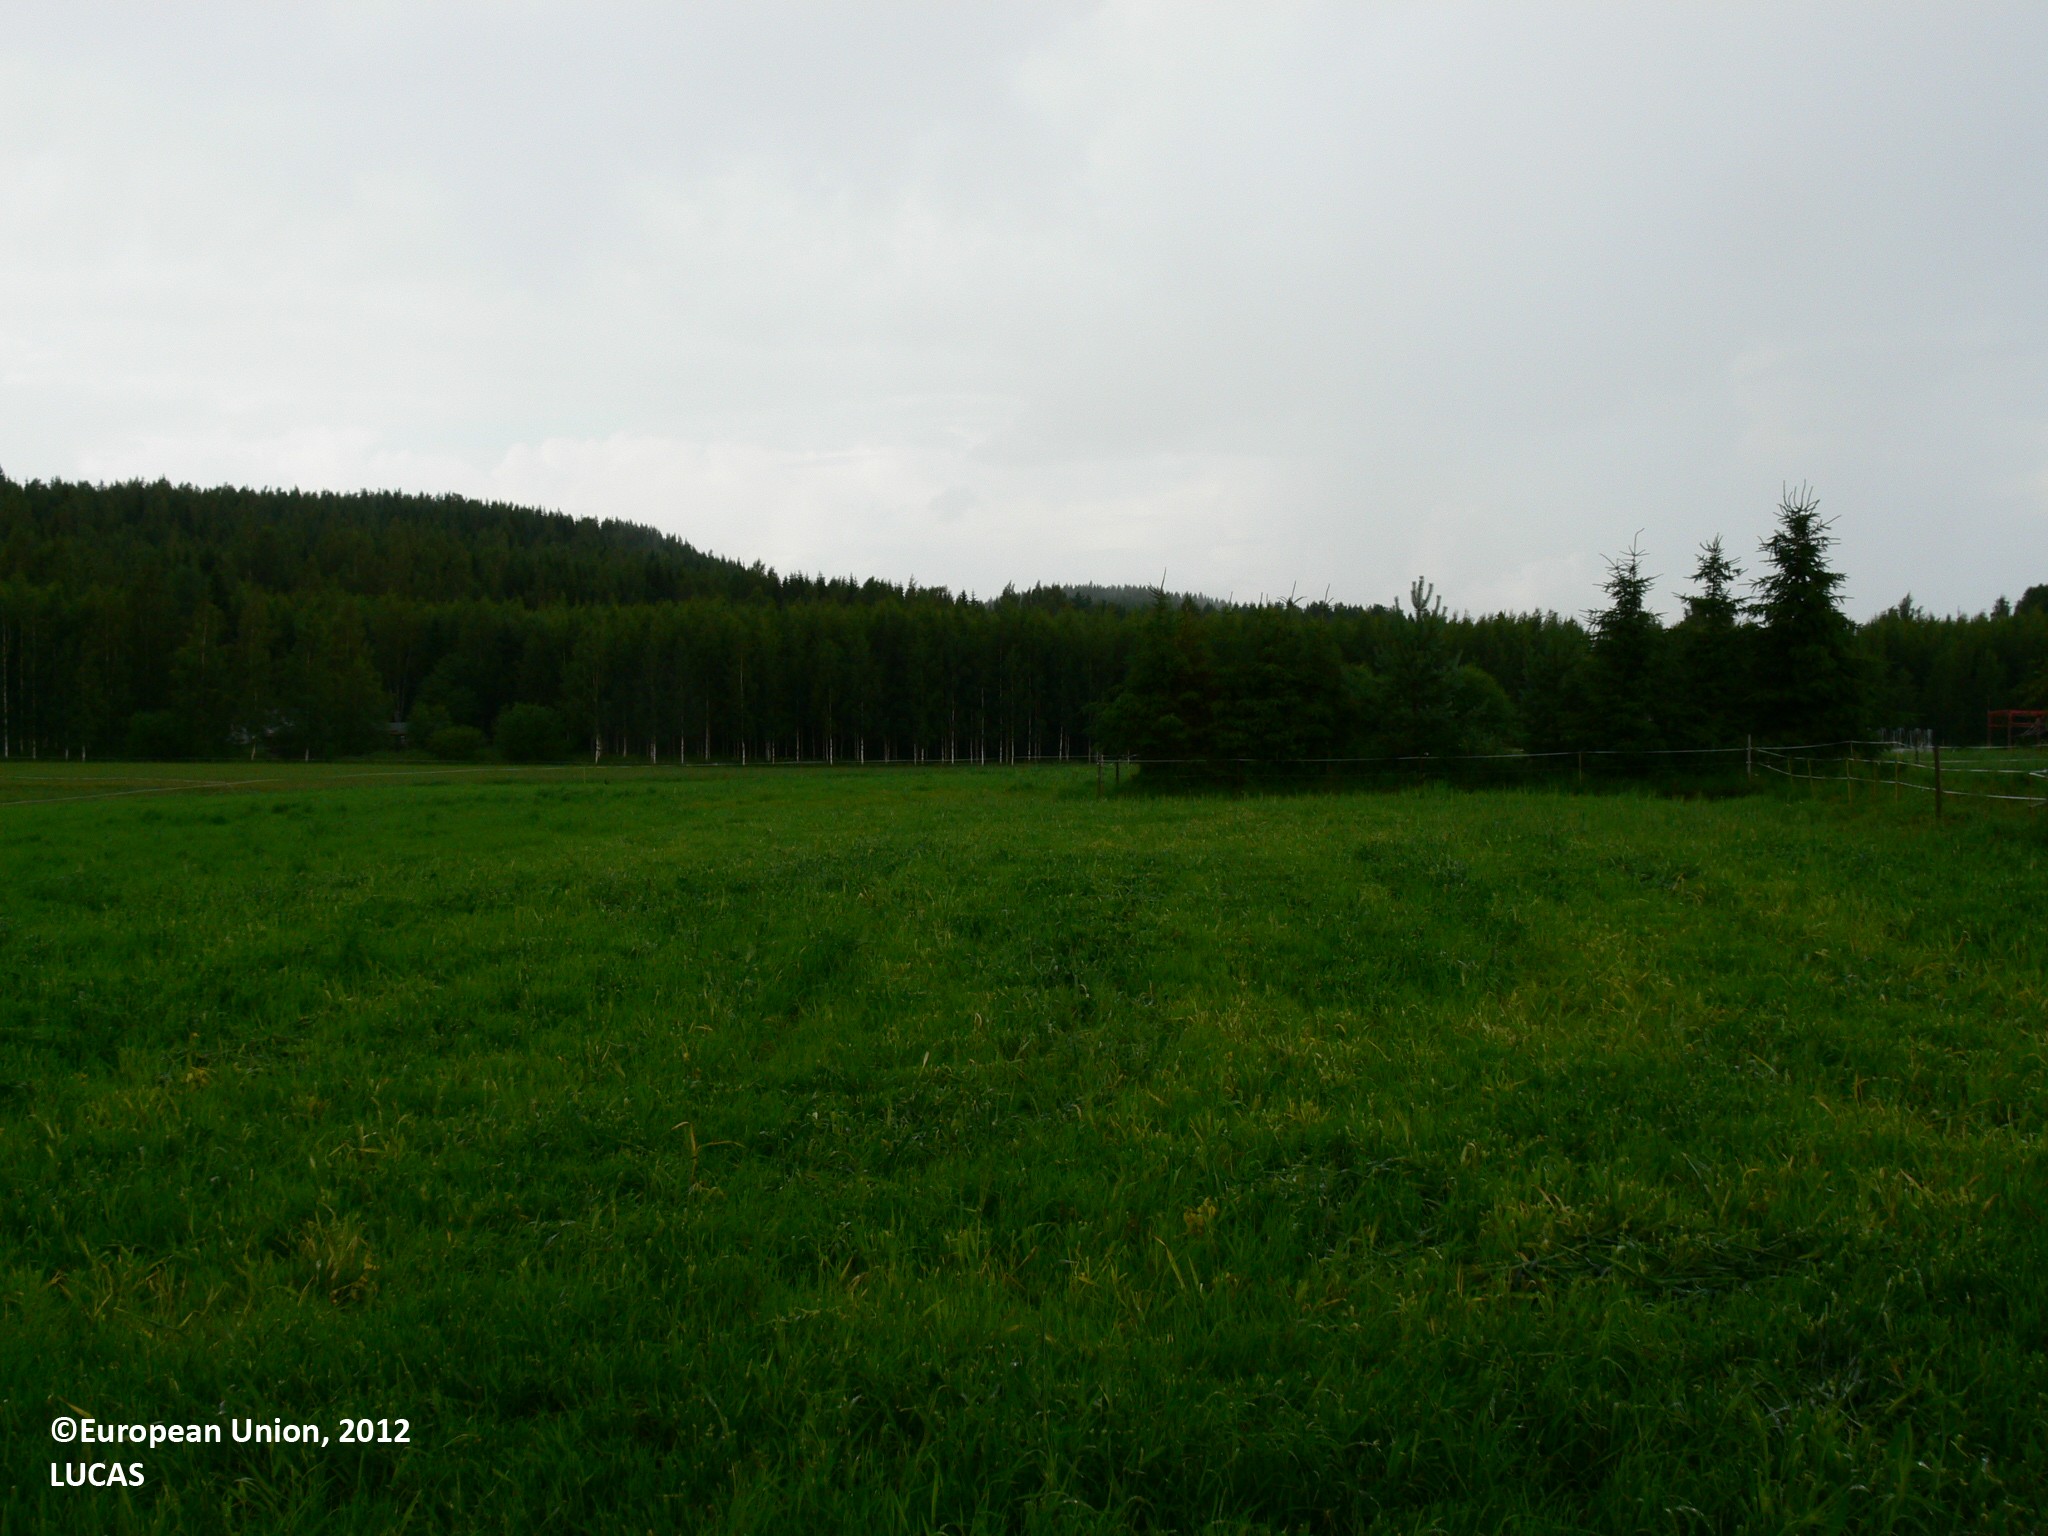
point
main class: Cropland
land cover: Temporary grasslands
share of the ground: > 75 %
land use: Agriculture (excluding fallow land and kitchen gardens)
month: July
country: FI
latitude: 63.2654
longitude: 30.0377
